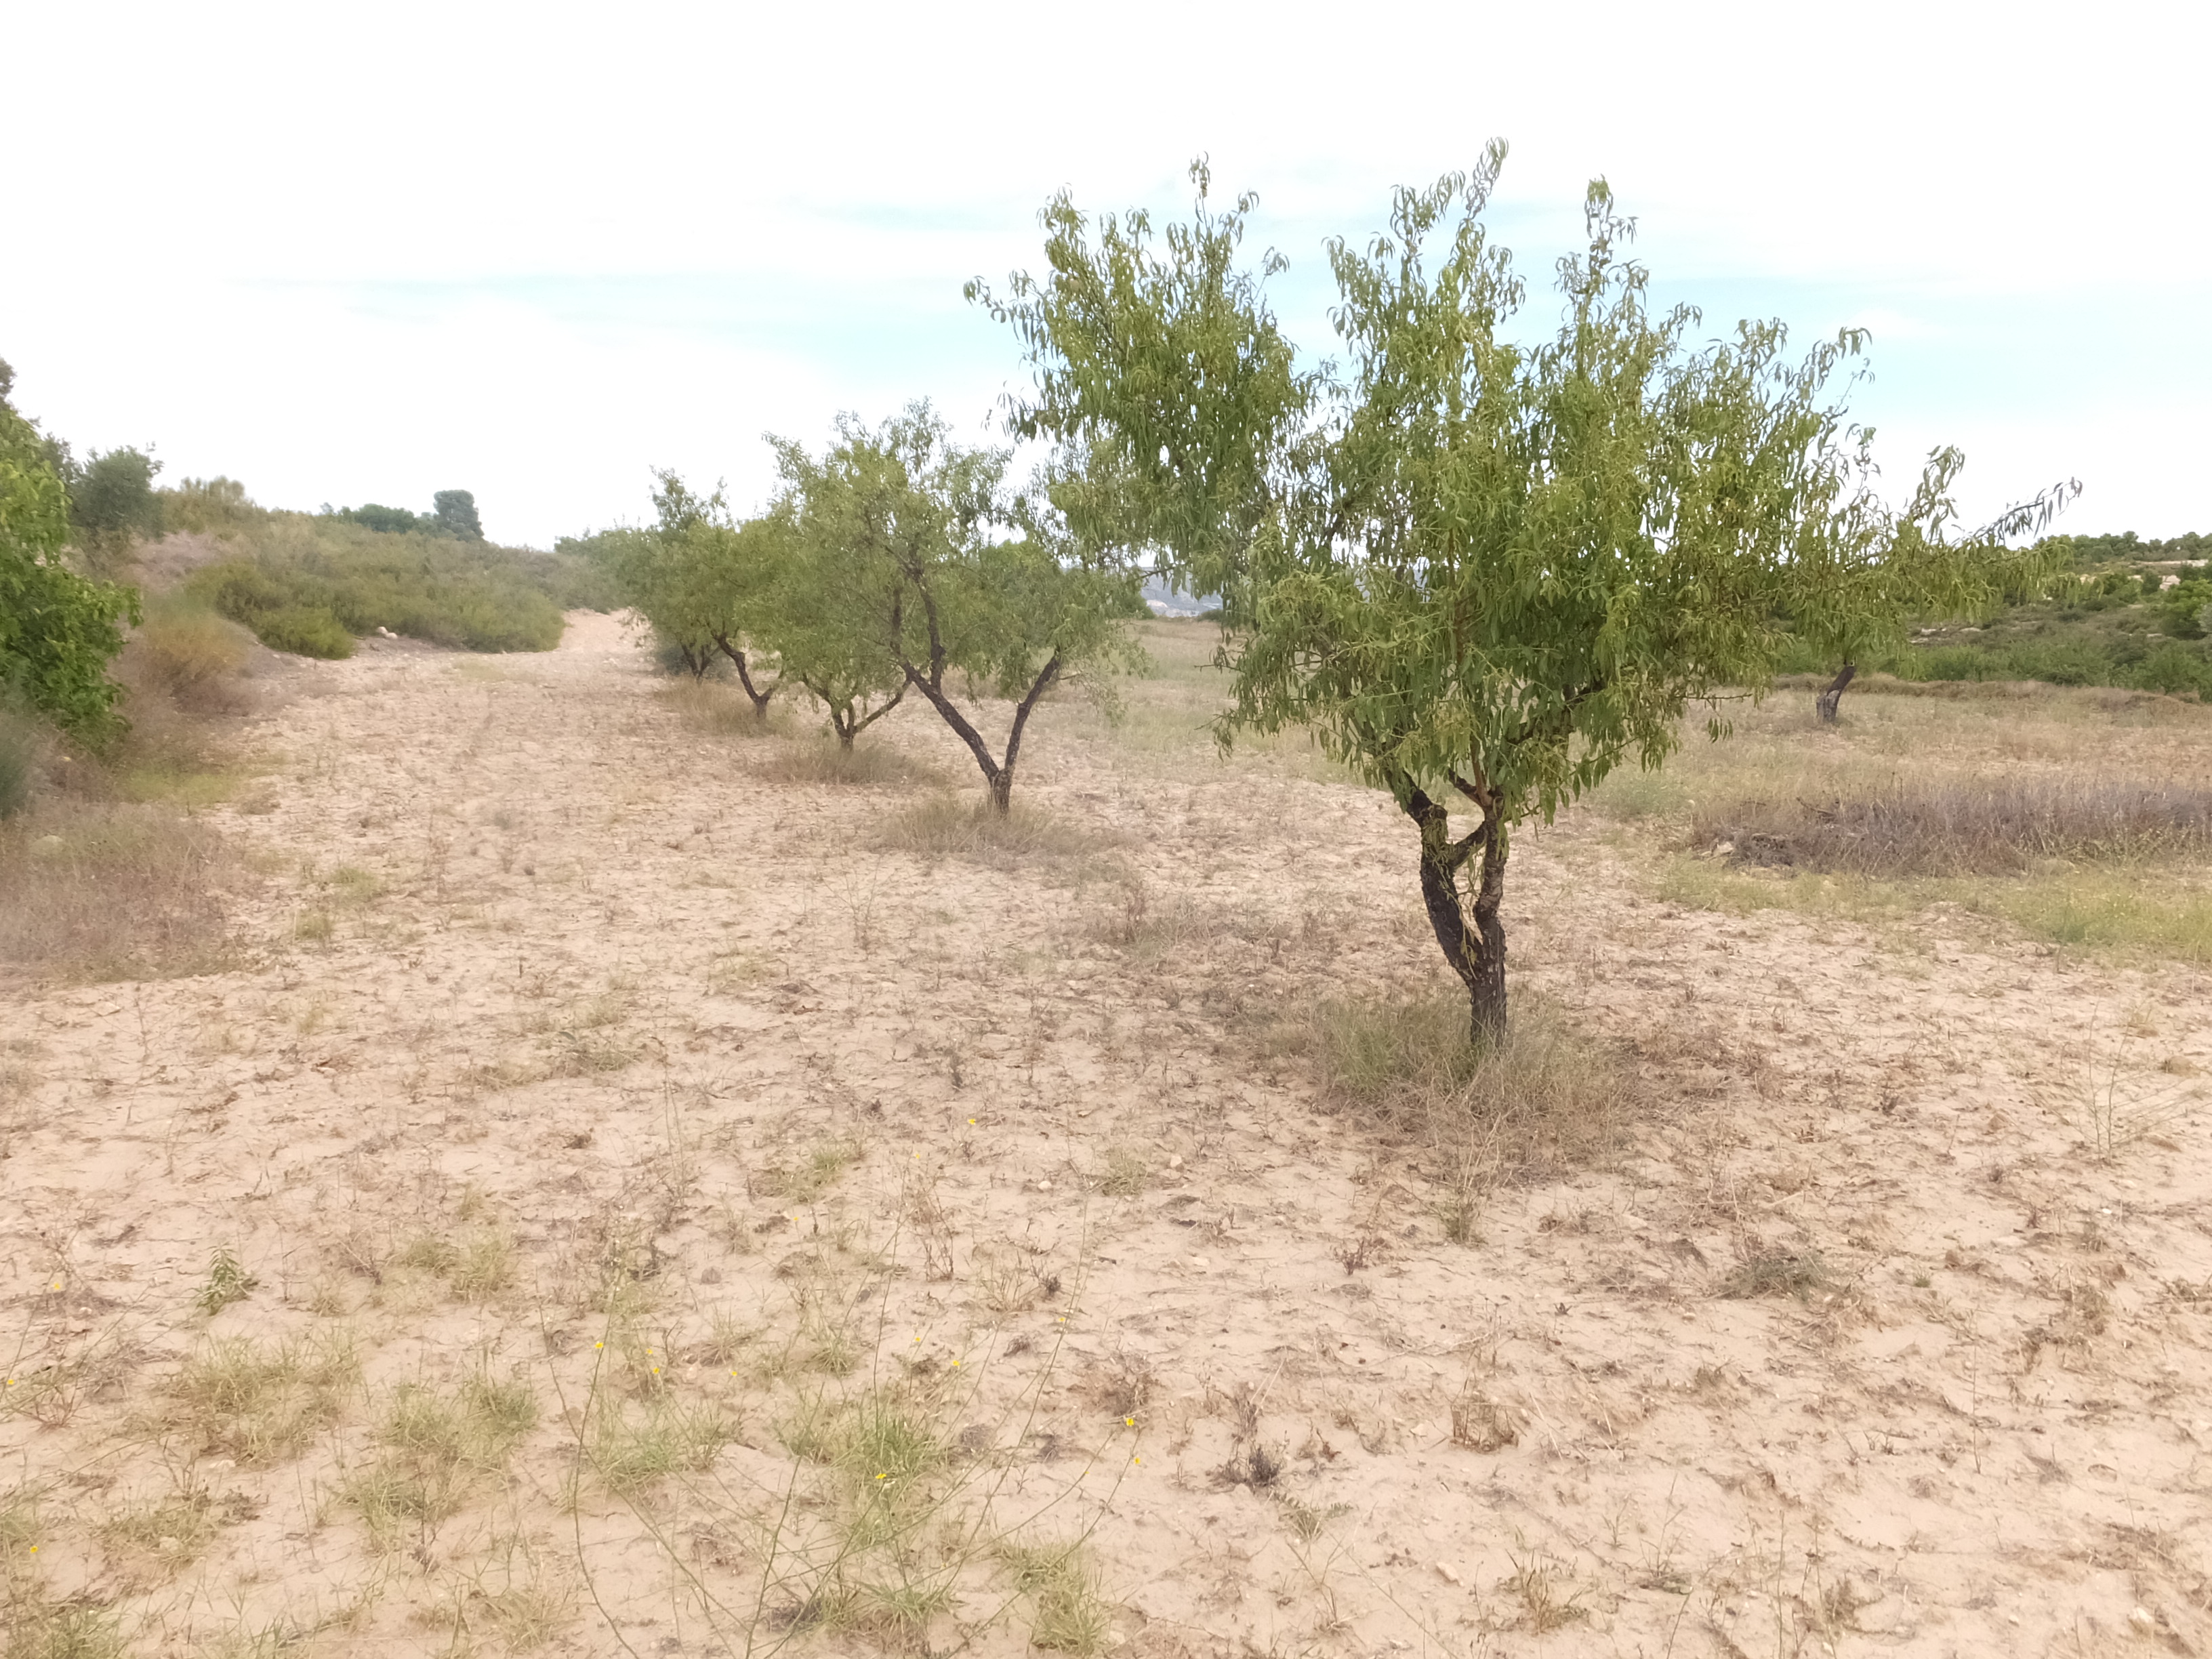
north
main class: Cropland
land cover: Nuts trees
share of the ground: > 75 %
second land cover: Other bare soil
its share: > 75 %
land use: Agriculture (excluding fallow land and kitchen gardens)
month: August
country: ES
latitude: 41.3326
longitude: 0.2980
